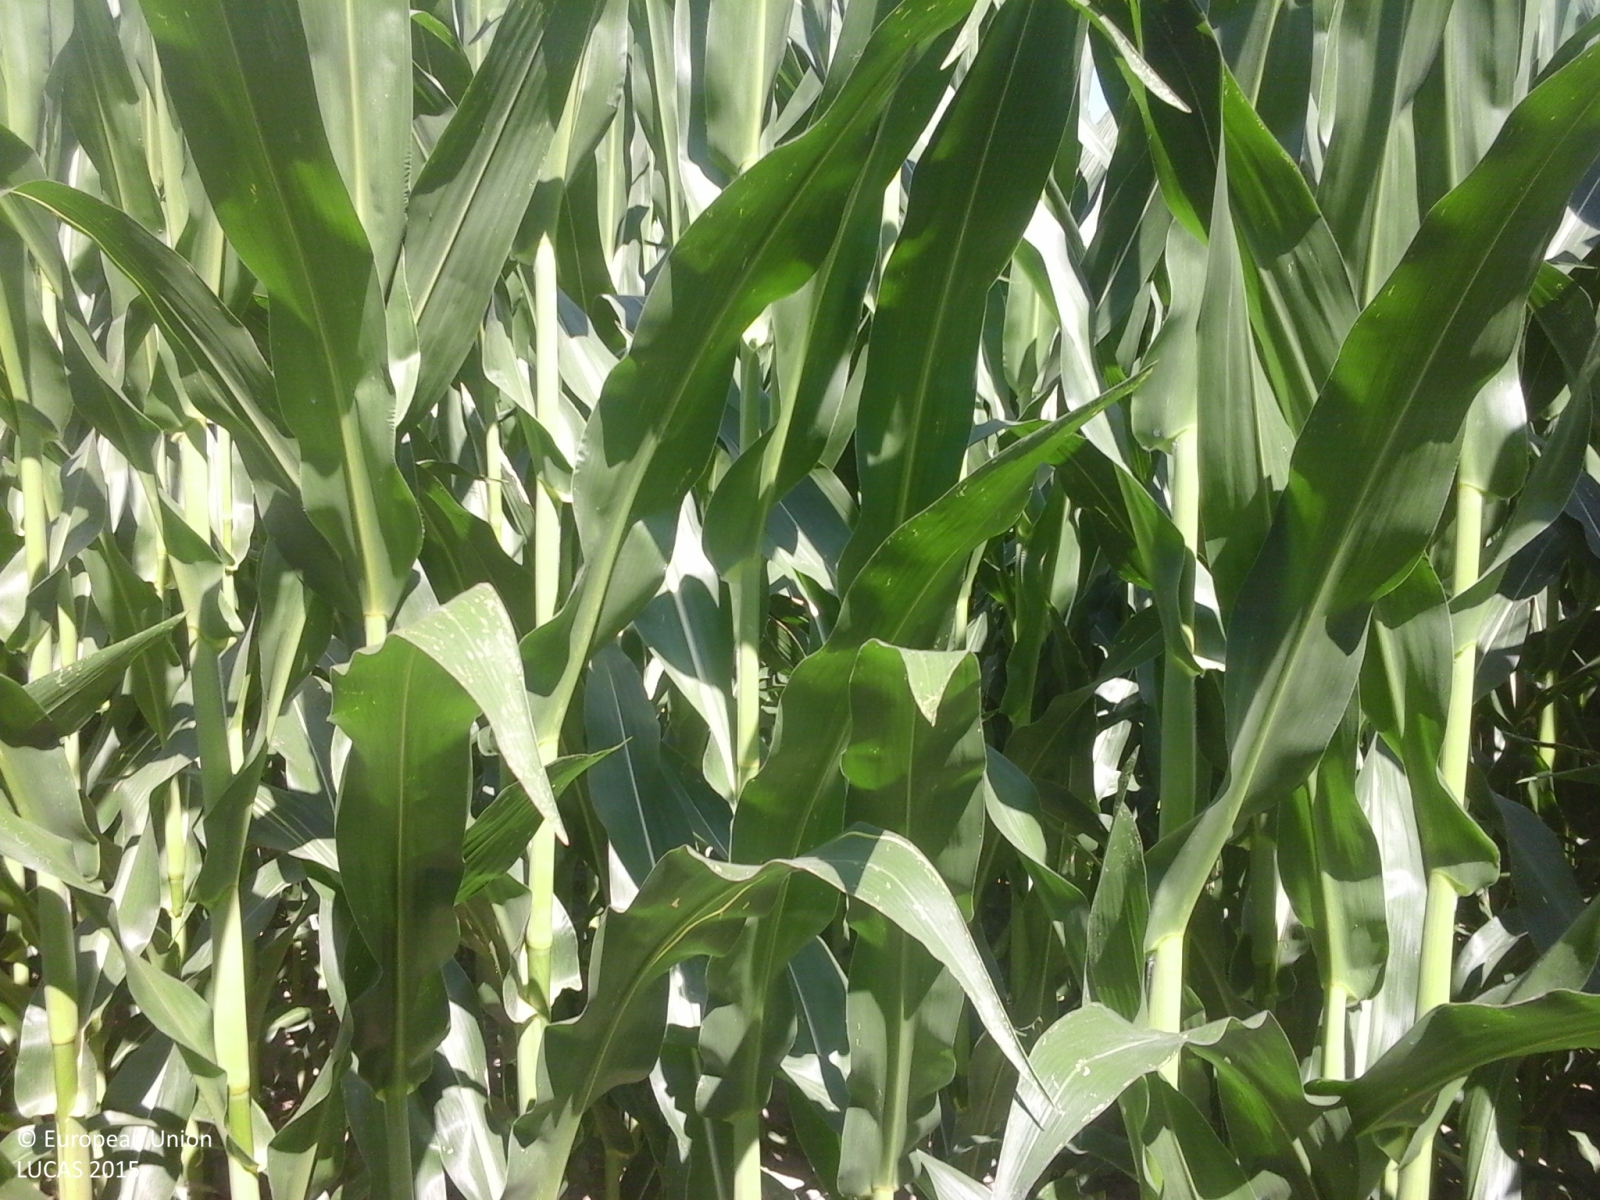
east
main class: Cropland
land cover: Maize
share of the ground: > 75 %
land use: Agriculture (excluding fallow land and kitchen gardens)
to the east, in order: Maize; Ditches and canals; Maize; Ditches and canals; Maize; Ditches and canals; Maize
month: June
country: IT
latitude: 45.0804
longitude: 8.5925
